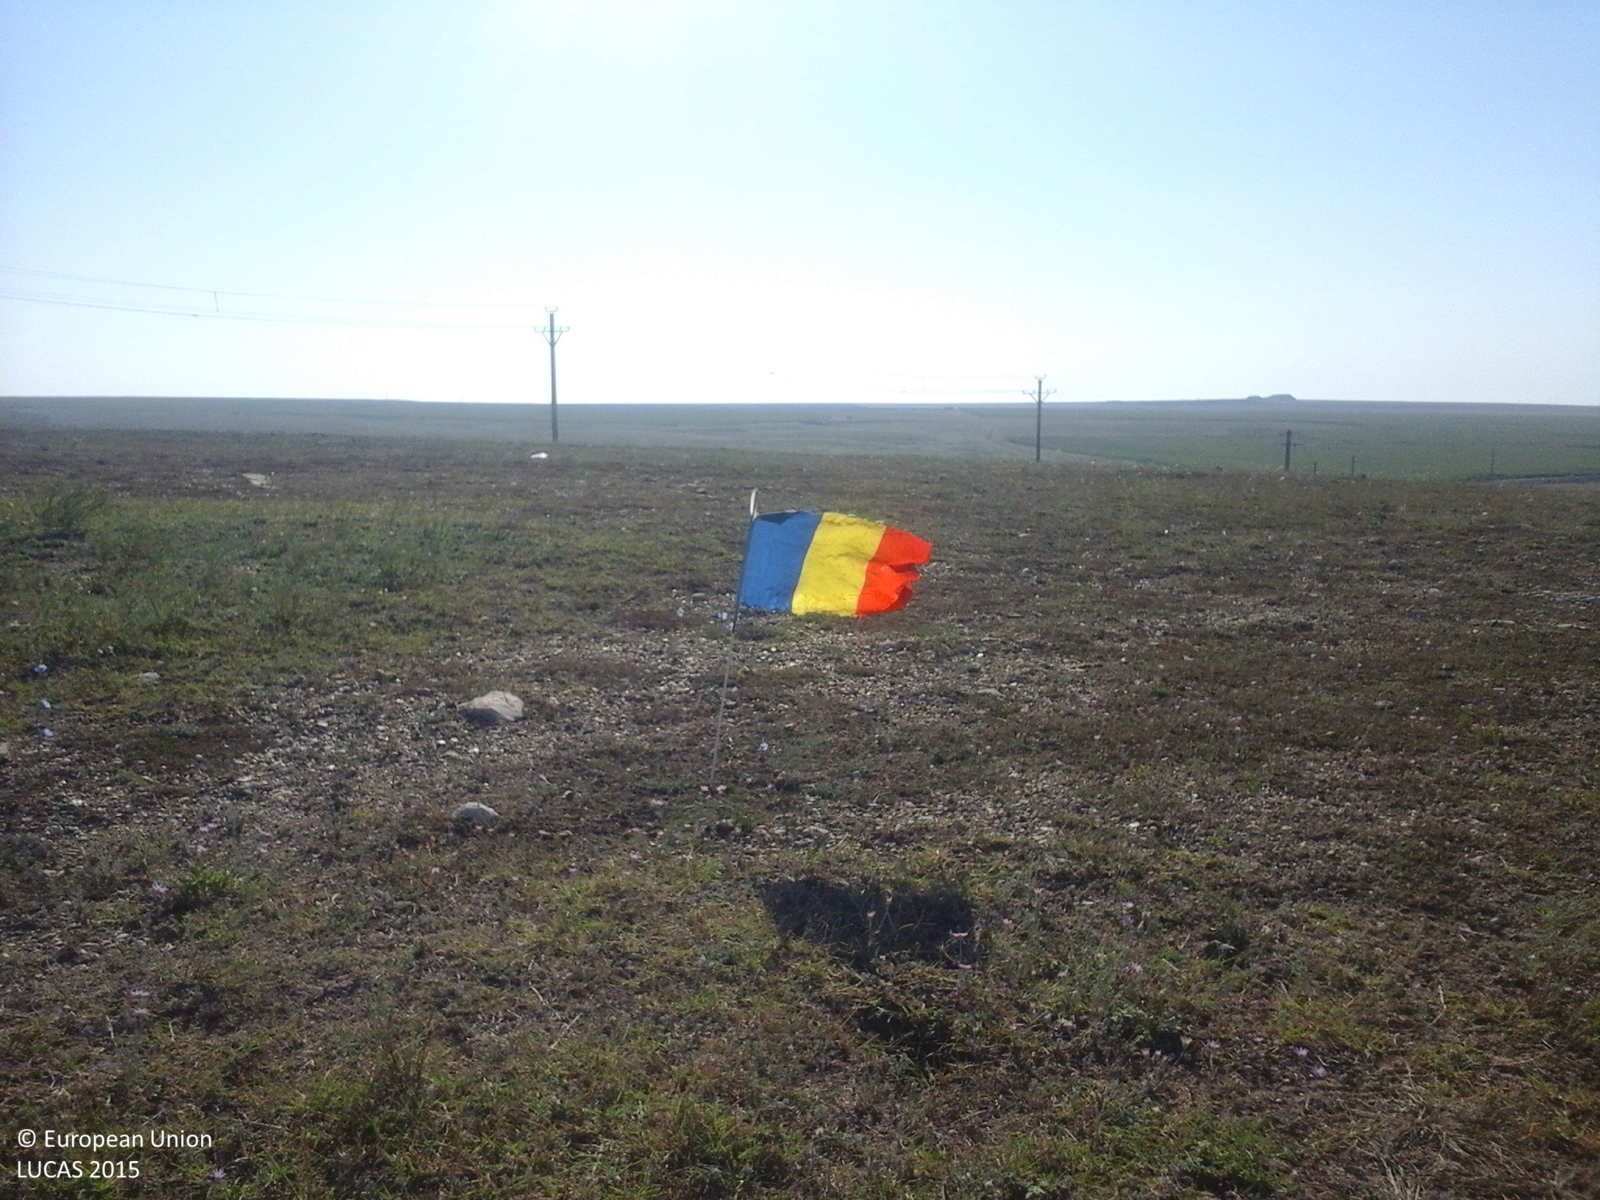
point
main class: Grassland
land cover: Grassland without tree/shrub cover
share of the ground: > 75 %
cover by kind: herbaceous plants 100 %
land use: Agriculture (excluding fallow land and kitchen gardens)
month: August
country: RO
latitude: 44.3930
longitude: 28.5663
